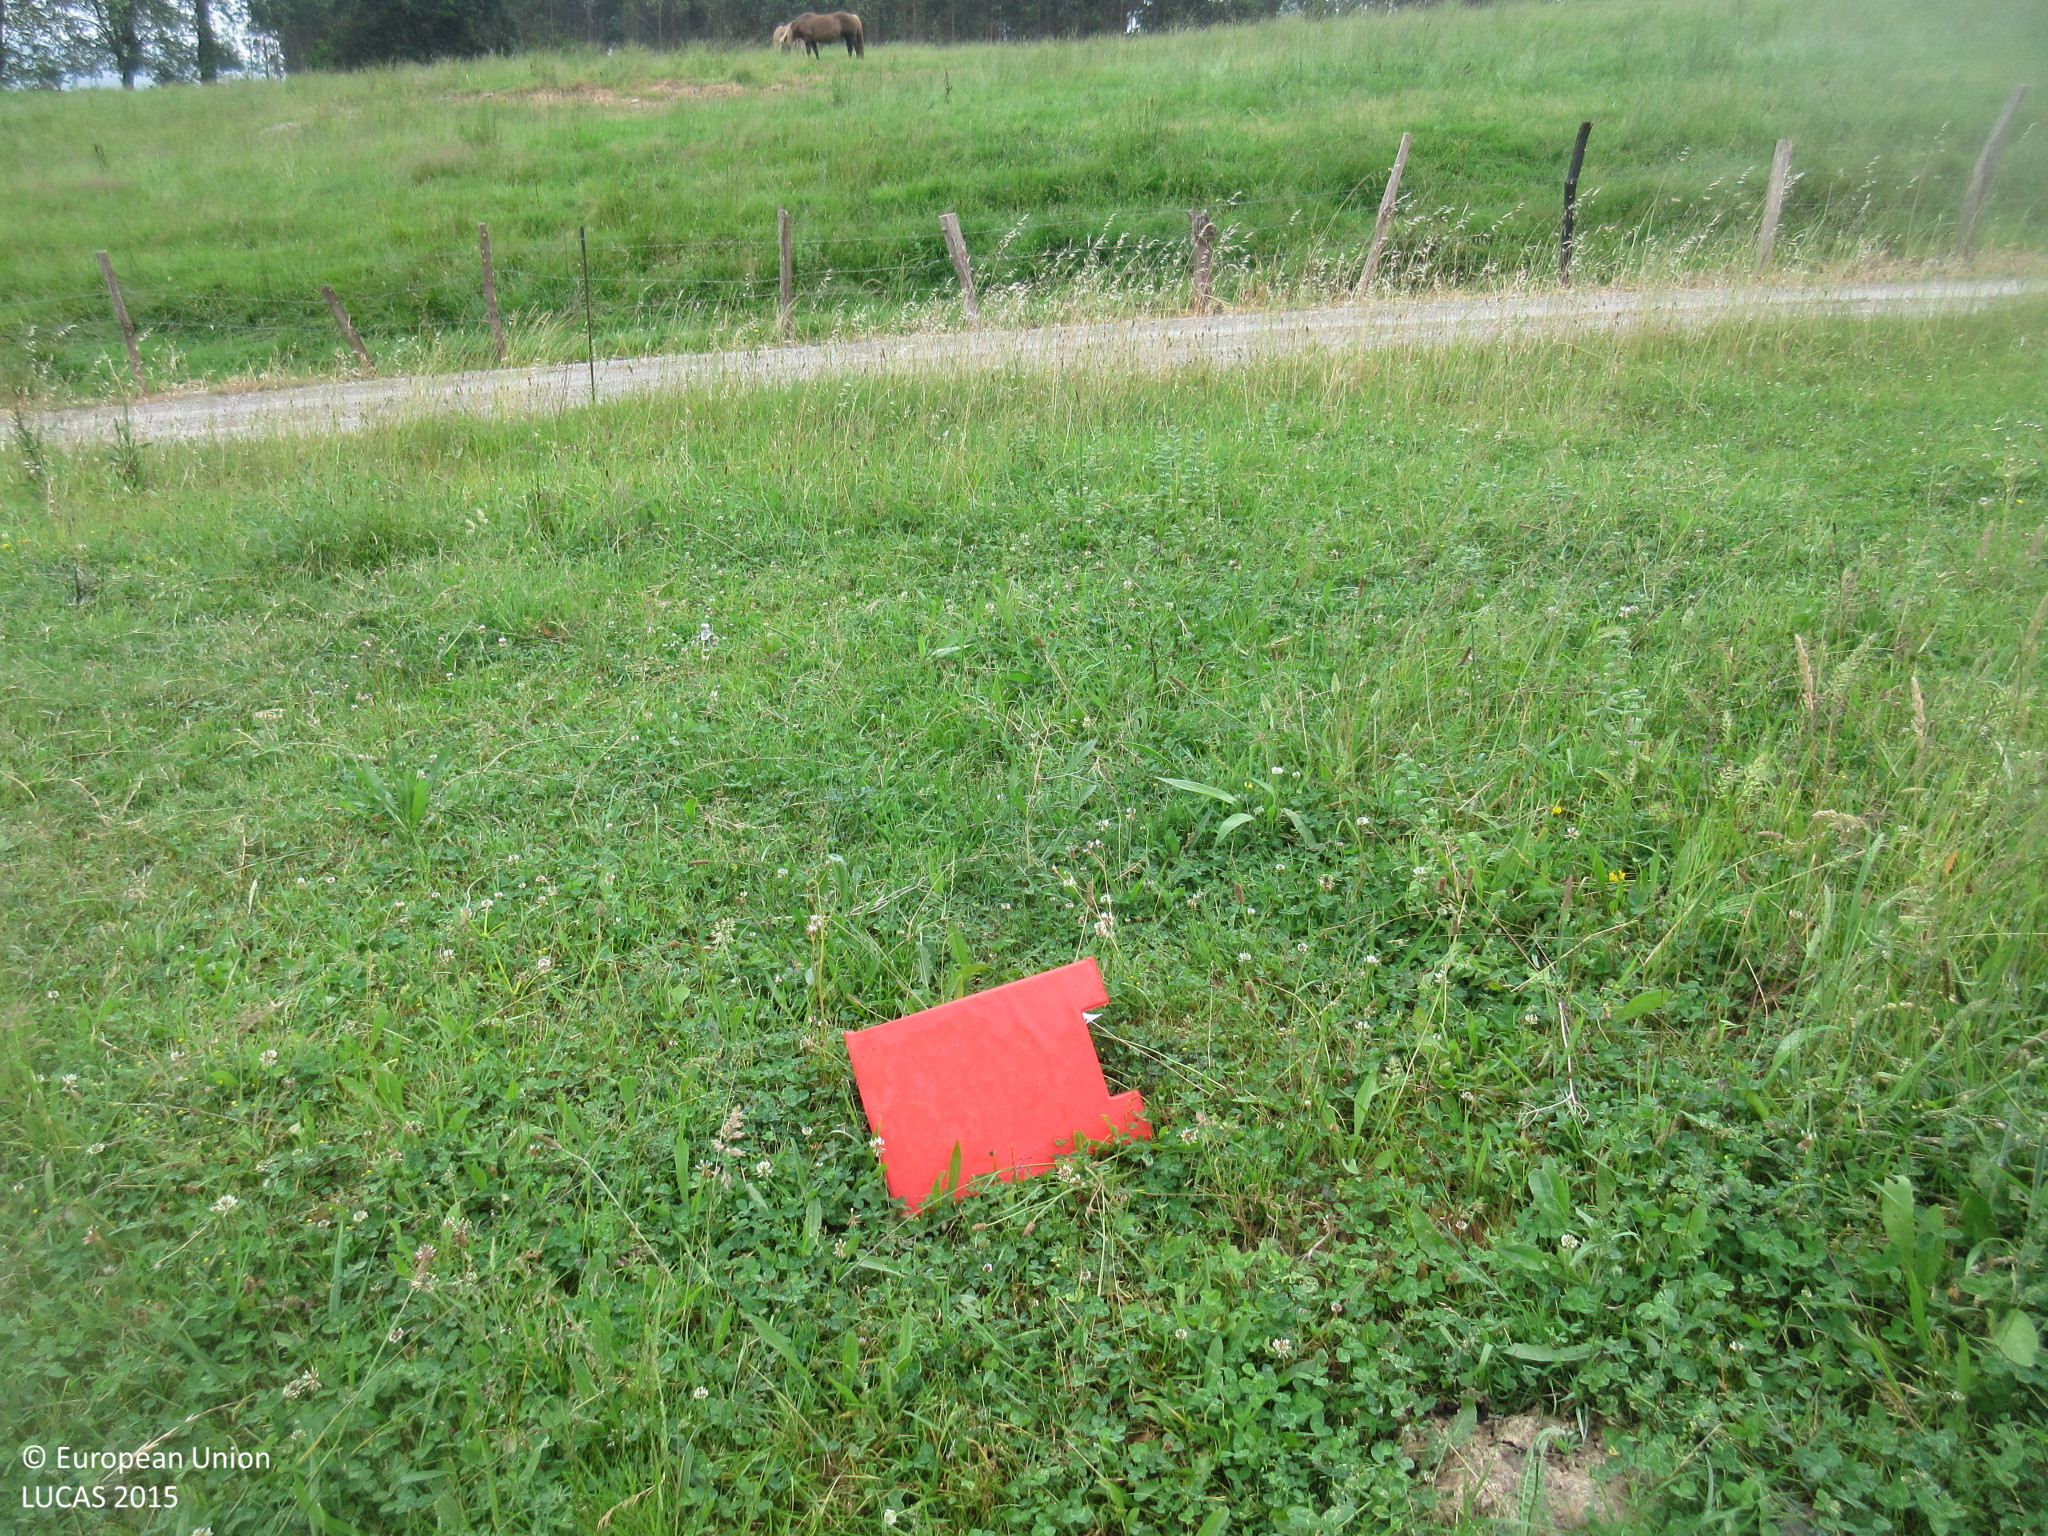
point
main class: Grassland
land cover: Grassland without tree/shrub cover
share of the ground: > 75 %
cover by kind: herbaceous plants 100 %
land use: Agriculture (excluding fallow land and kitchen gardens)
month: June
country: ES
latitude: 43.3793
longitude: -3.5850
